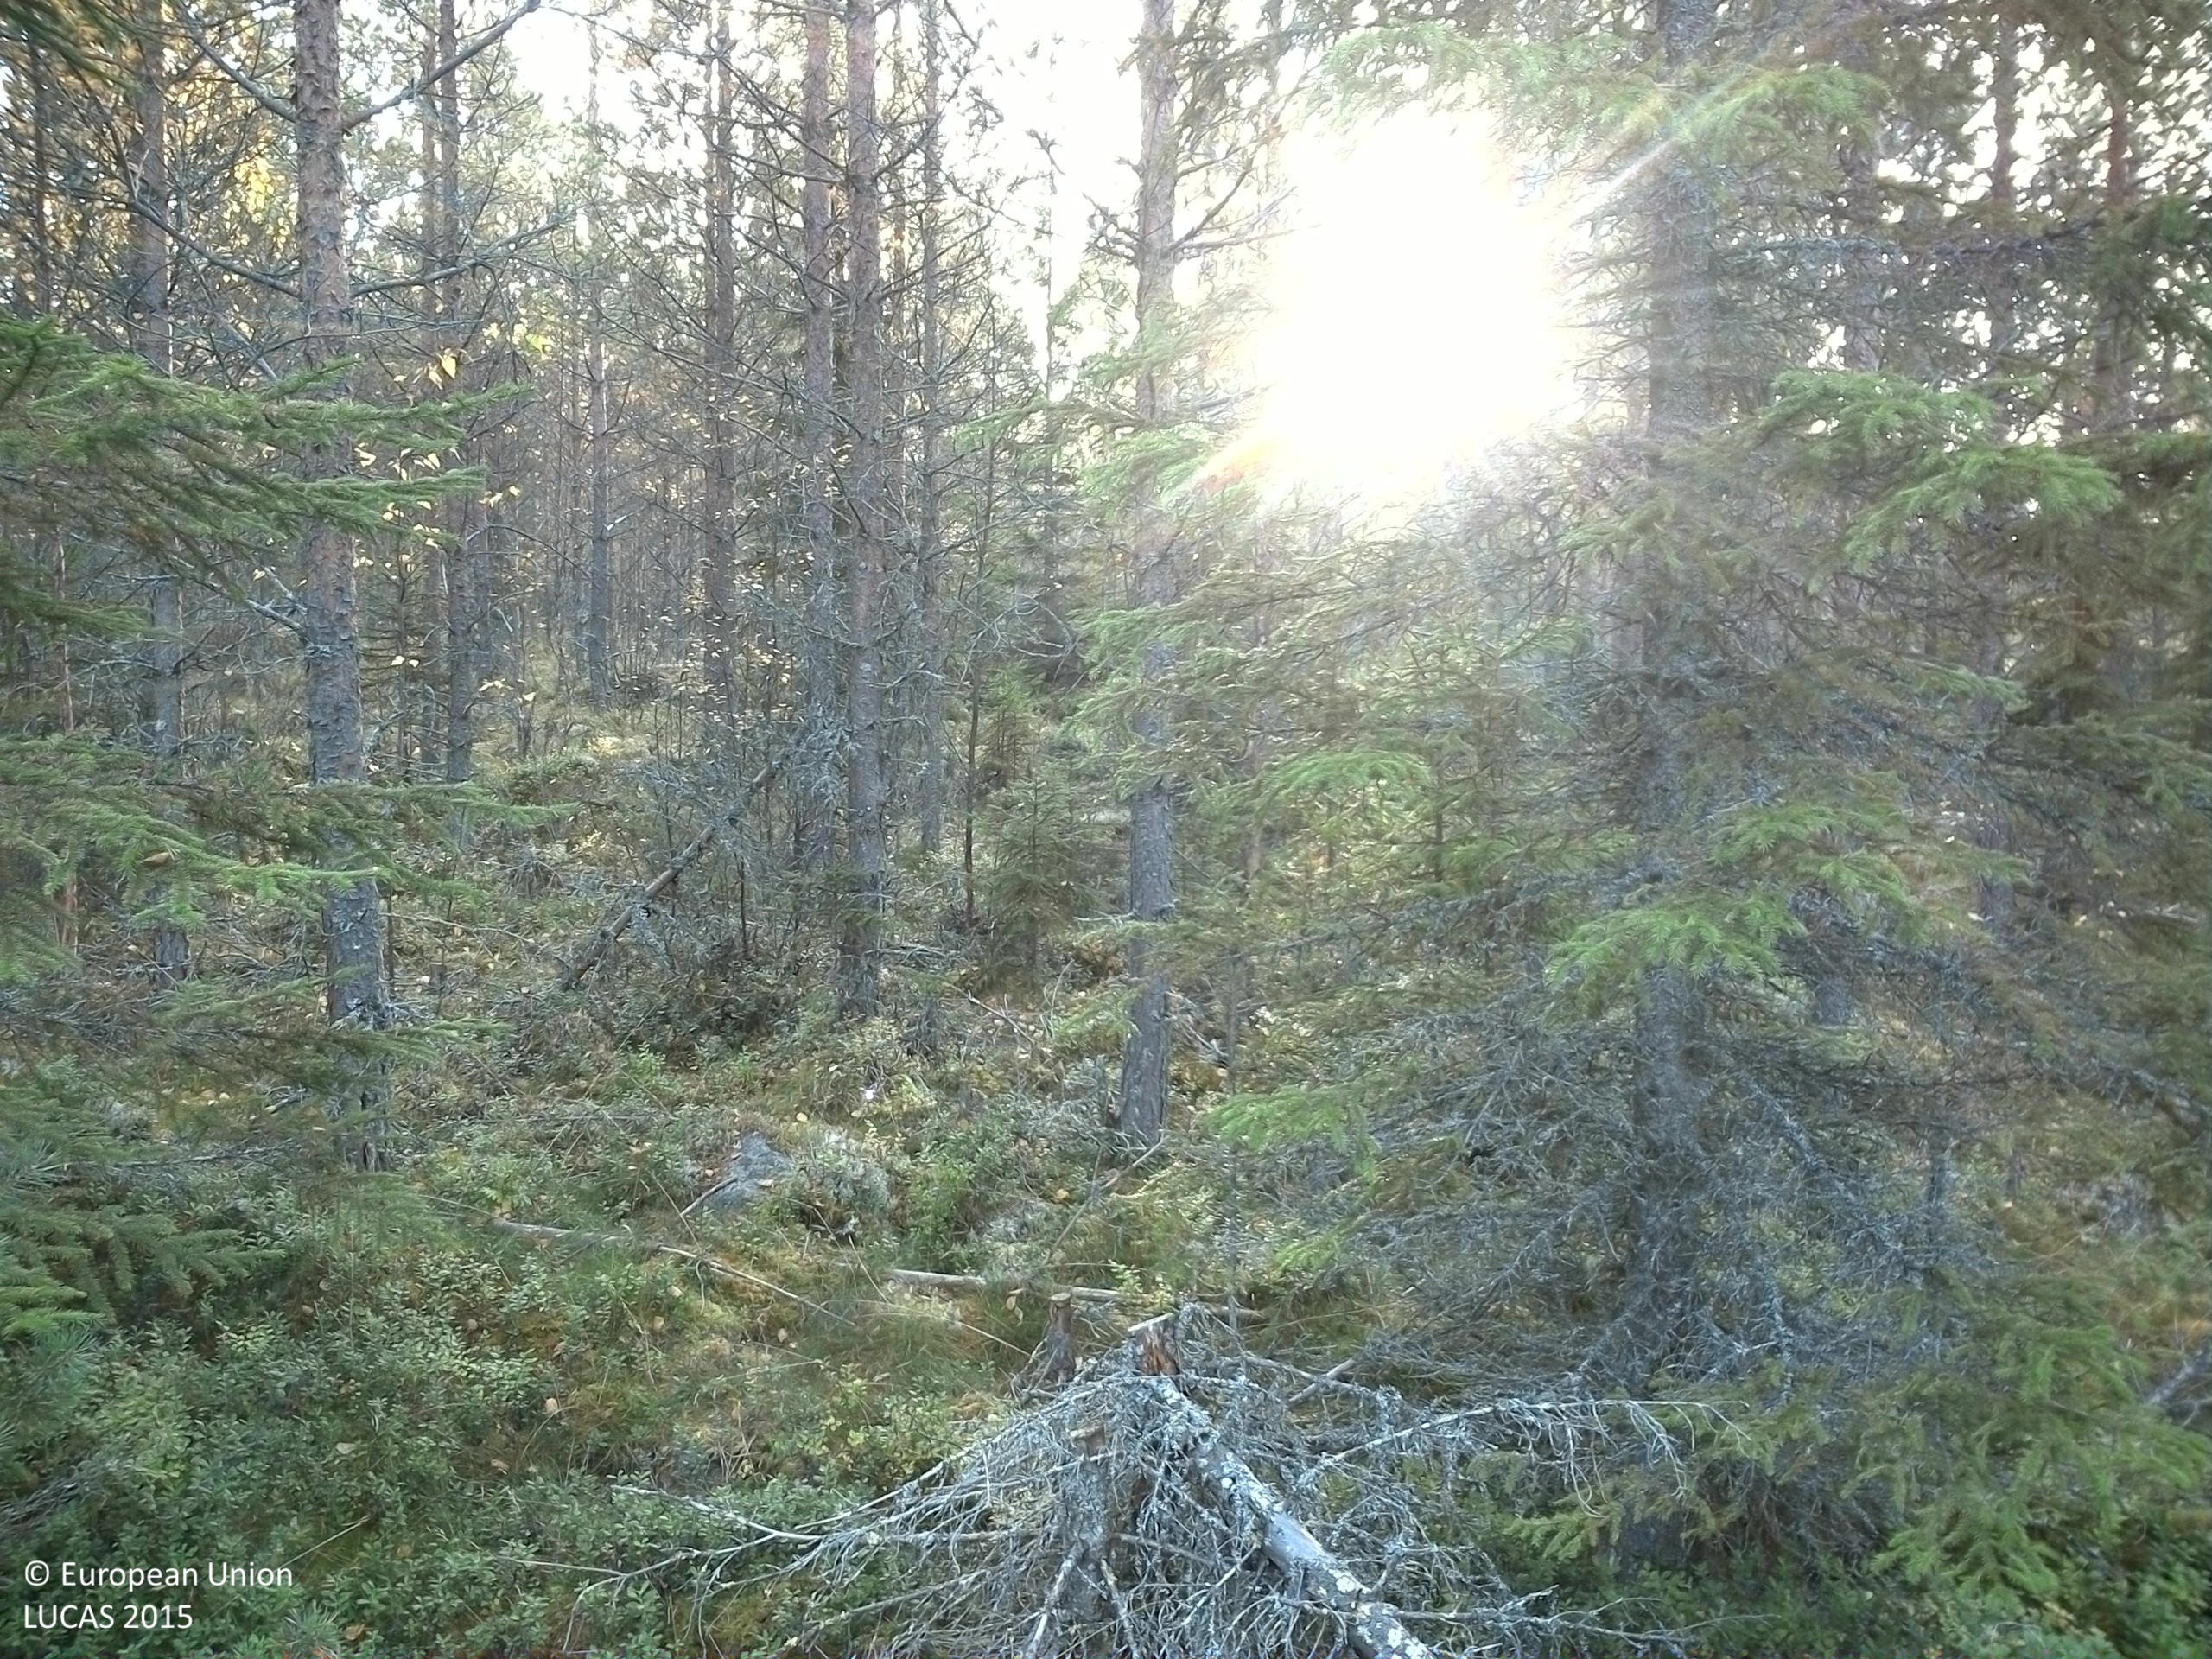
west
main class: Woodland
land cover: Other coniferous woodland
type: boreal forest
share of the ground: 50 - 75 %
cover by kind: coniferous forest trees 55 %, shrubs 25 %, lichens and mosses 10 %, broadleaved forest trees 5 %, consolidated bare surface 5 %
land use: Forestry
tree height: > 5 m
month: October
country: SE
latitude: 61.2805
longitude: 15.0780
